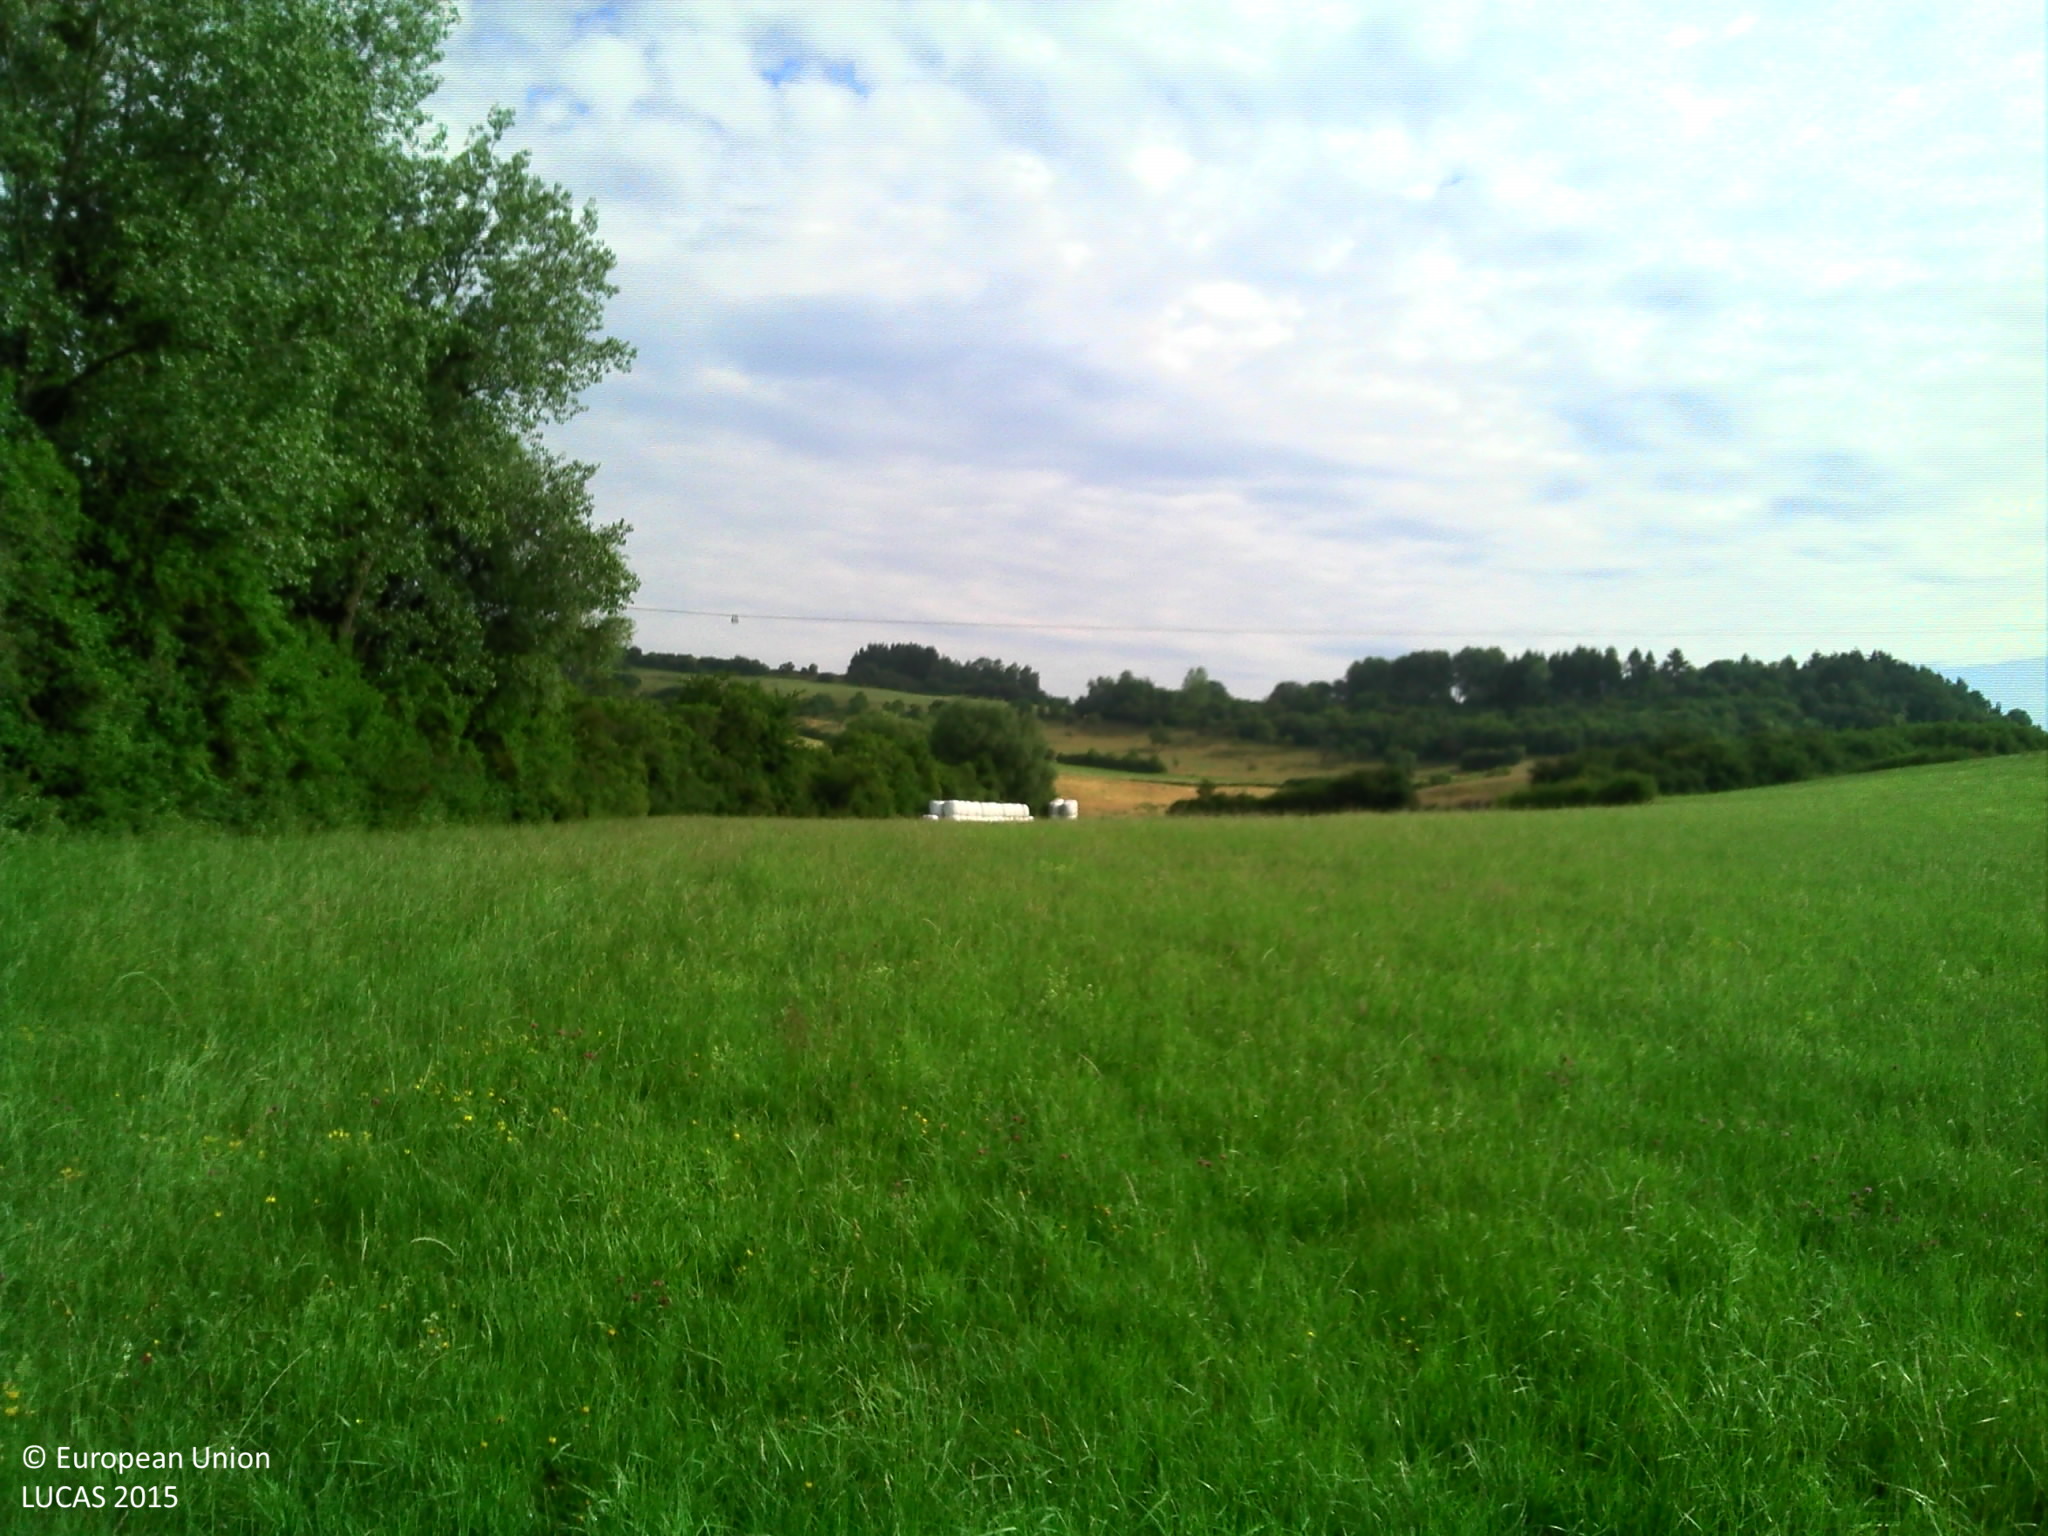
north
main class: Grassland
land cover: Grassland without tree/shrub cover
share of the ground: > 75 %
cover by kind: herbaceous plants 100 %
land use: Agriculture (excluding fallow land and kitchen gardens)
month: June
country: LU
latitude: 49.7487
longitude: 6.3773
